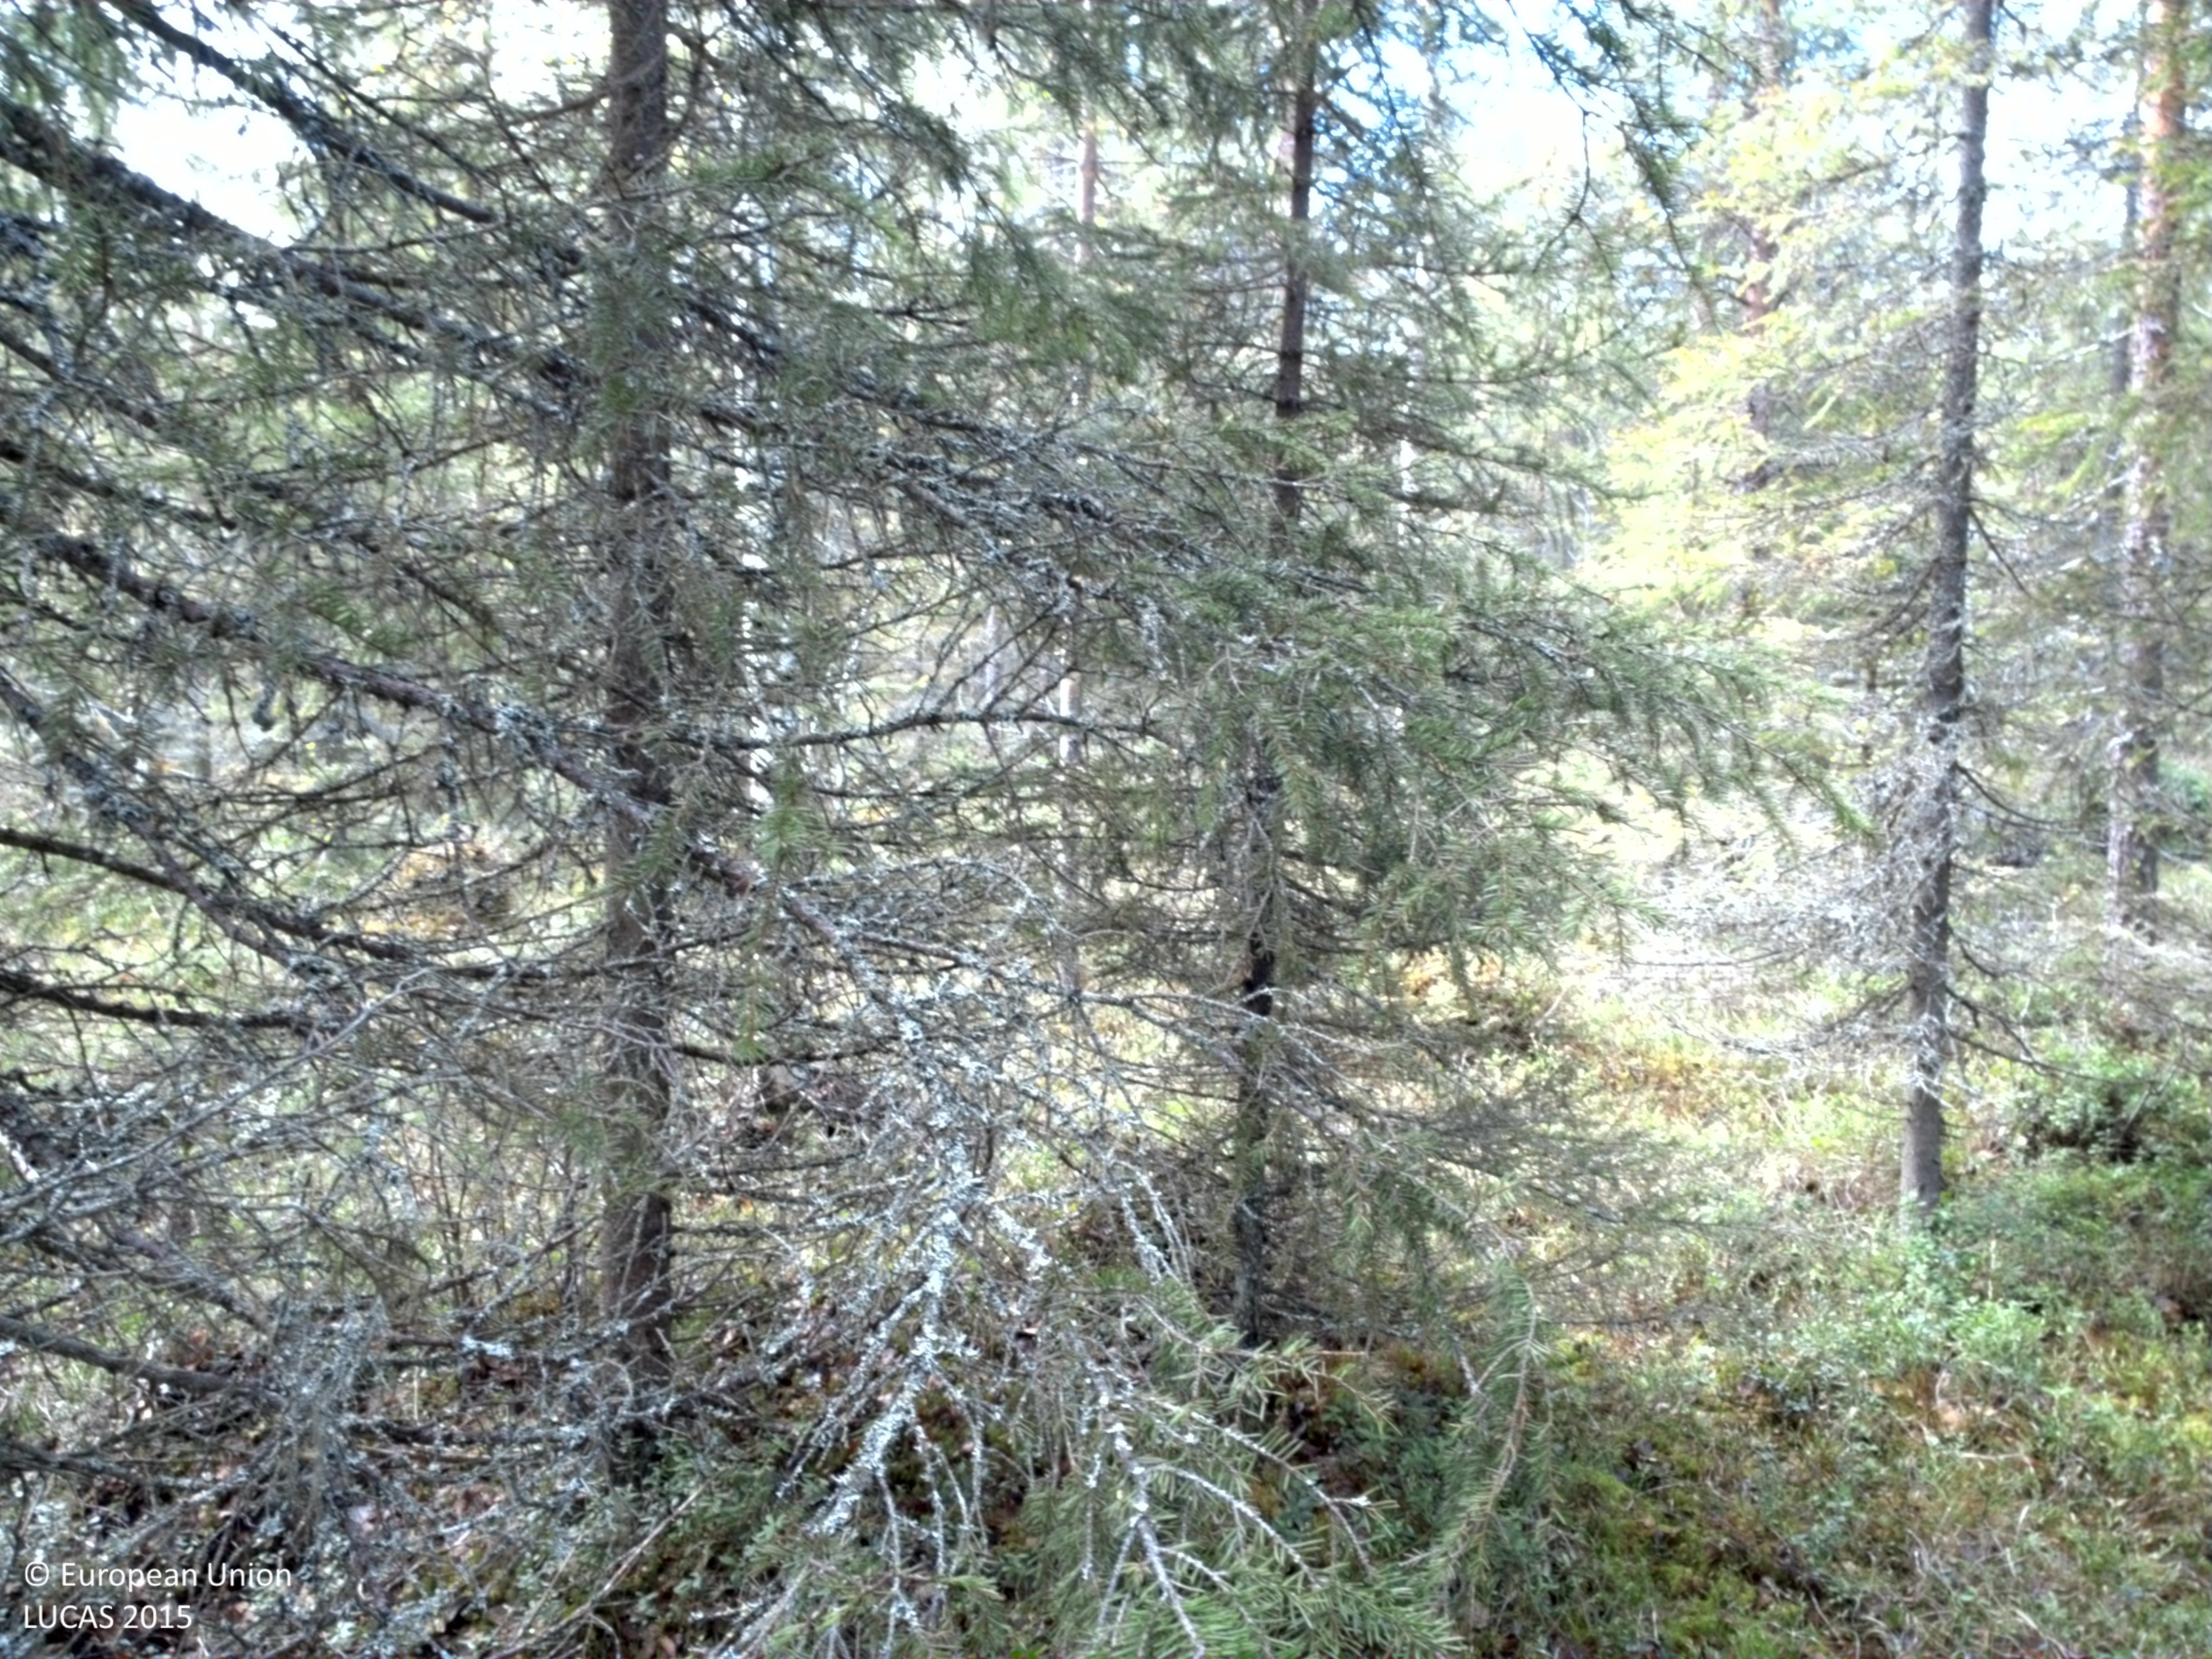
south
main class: Woodland
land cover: Other coniferous woodland
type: boreal forest
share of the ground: > 75 %
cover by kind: coniferous forest trees 65 %, shrubs 25 %, broadleaved forest trees 10 %
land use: Forestry
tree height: > 5 m
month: June
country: SE
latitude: 66.4170
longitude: 23.4465
